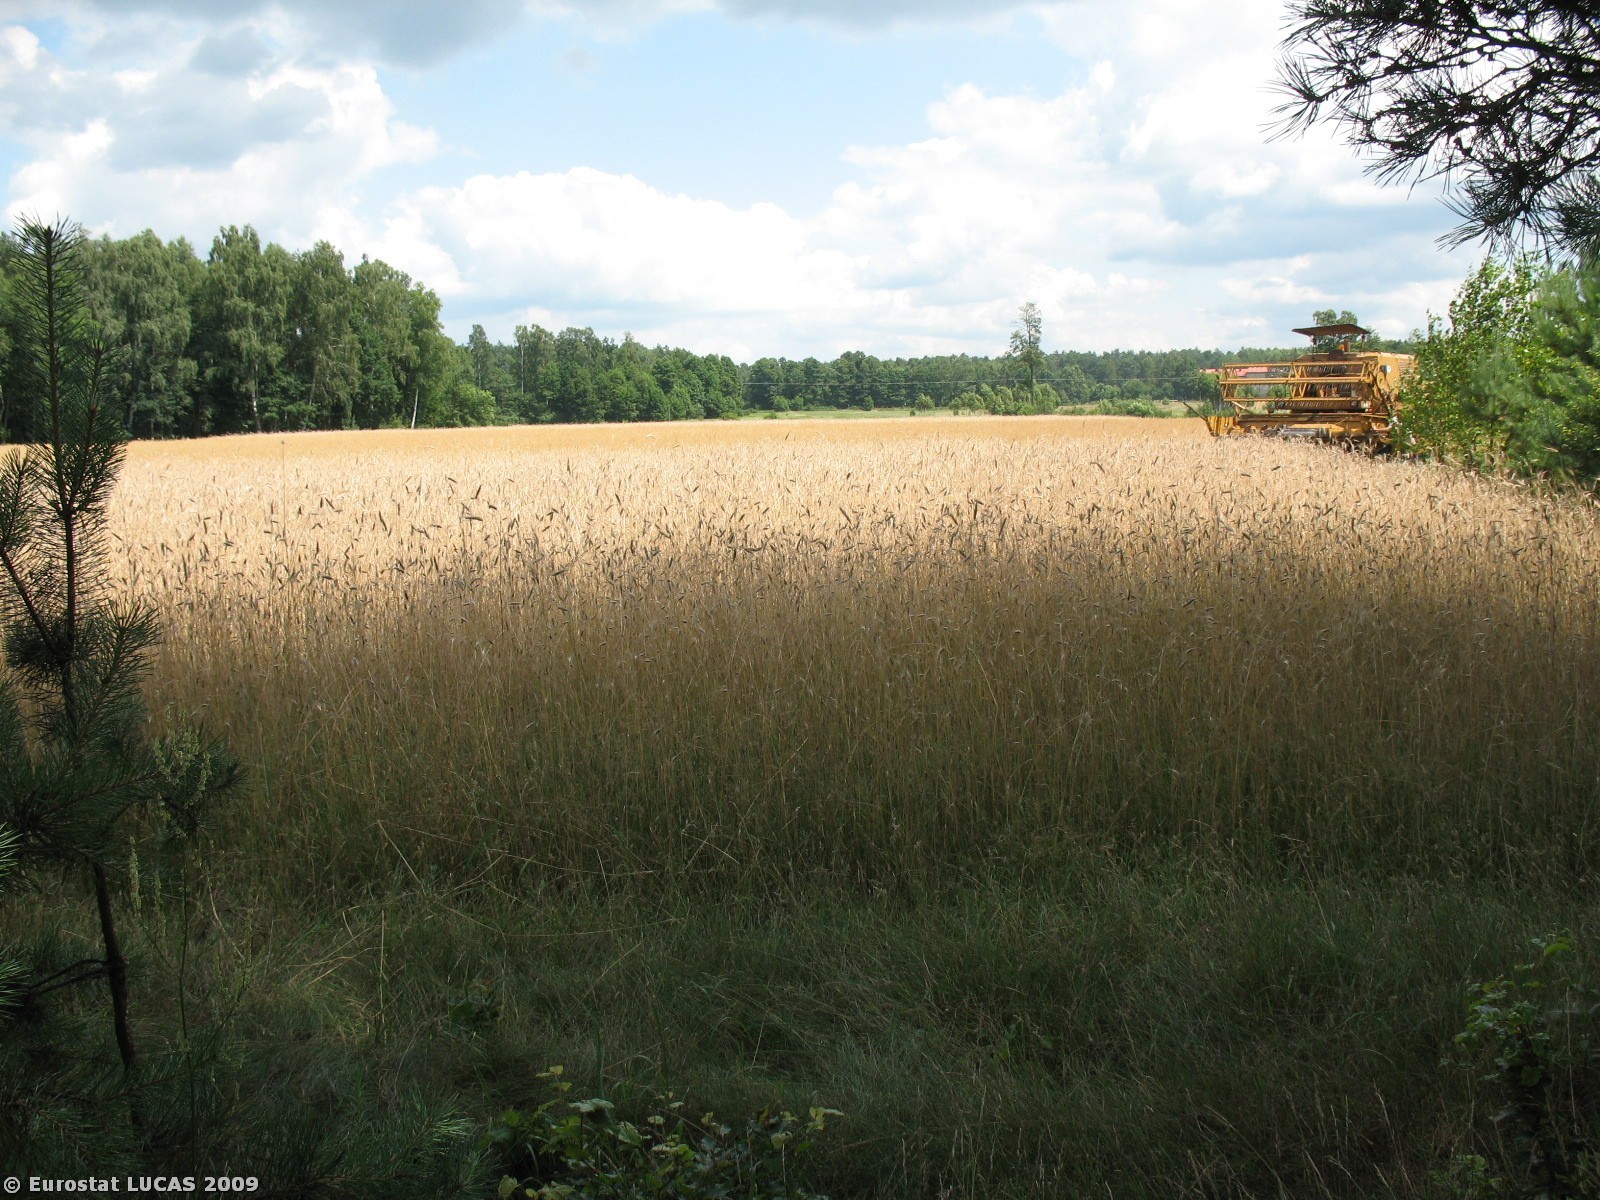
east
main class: Woodland
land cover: Coniferous woodland
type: hemiboreal forest and nemoral coniferous forest and mixed broadleaved-coniferous forest
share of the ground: > 75 %
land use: Forestry
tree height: > 5 m
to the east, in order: Coniferous woodland; Rye; Grassland without tree/shrub cover; Artificial constructions in urban areas; Grassland without tree/shrub cover
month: July
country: PL
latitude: 50.2634
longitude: 22.1096
